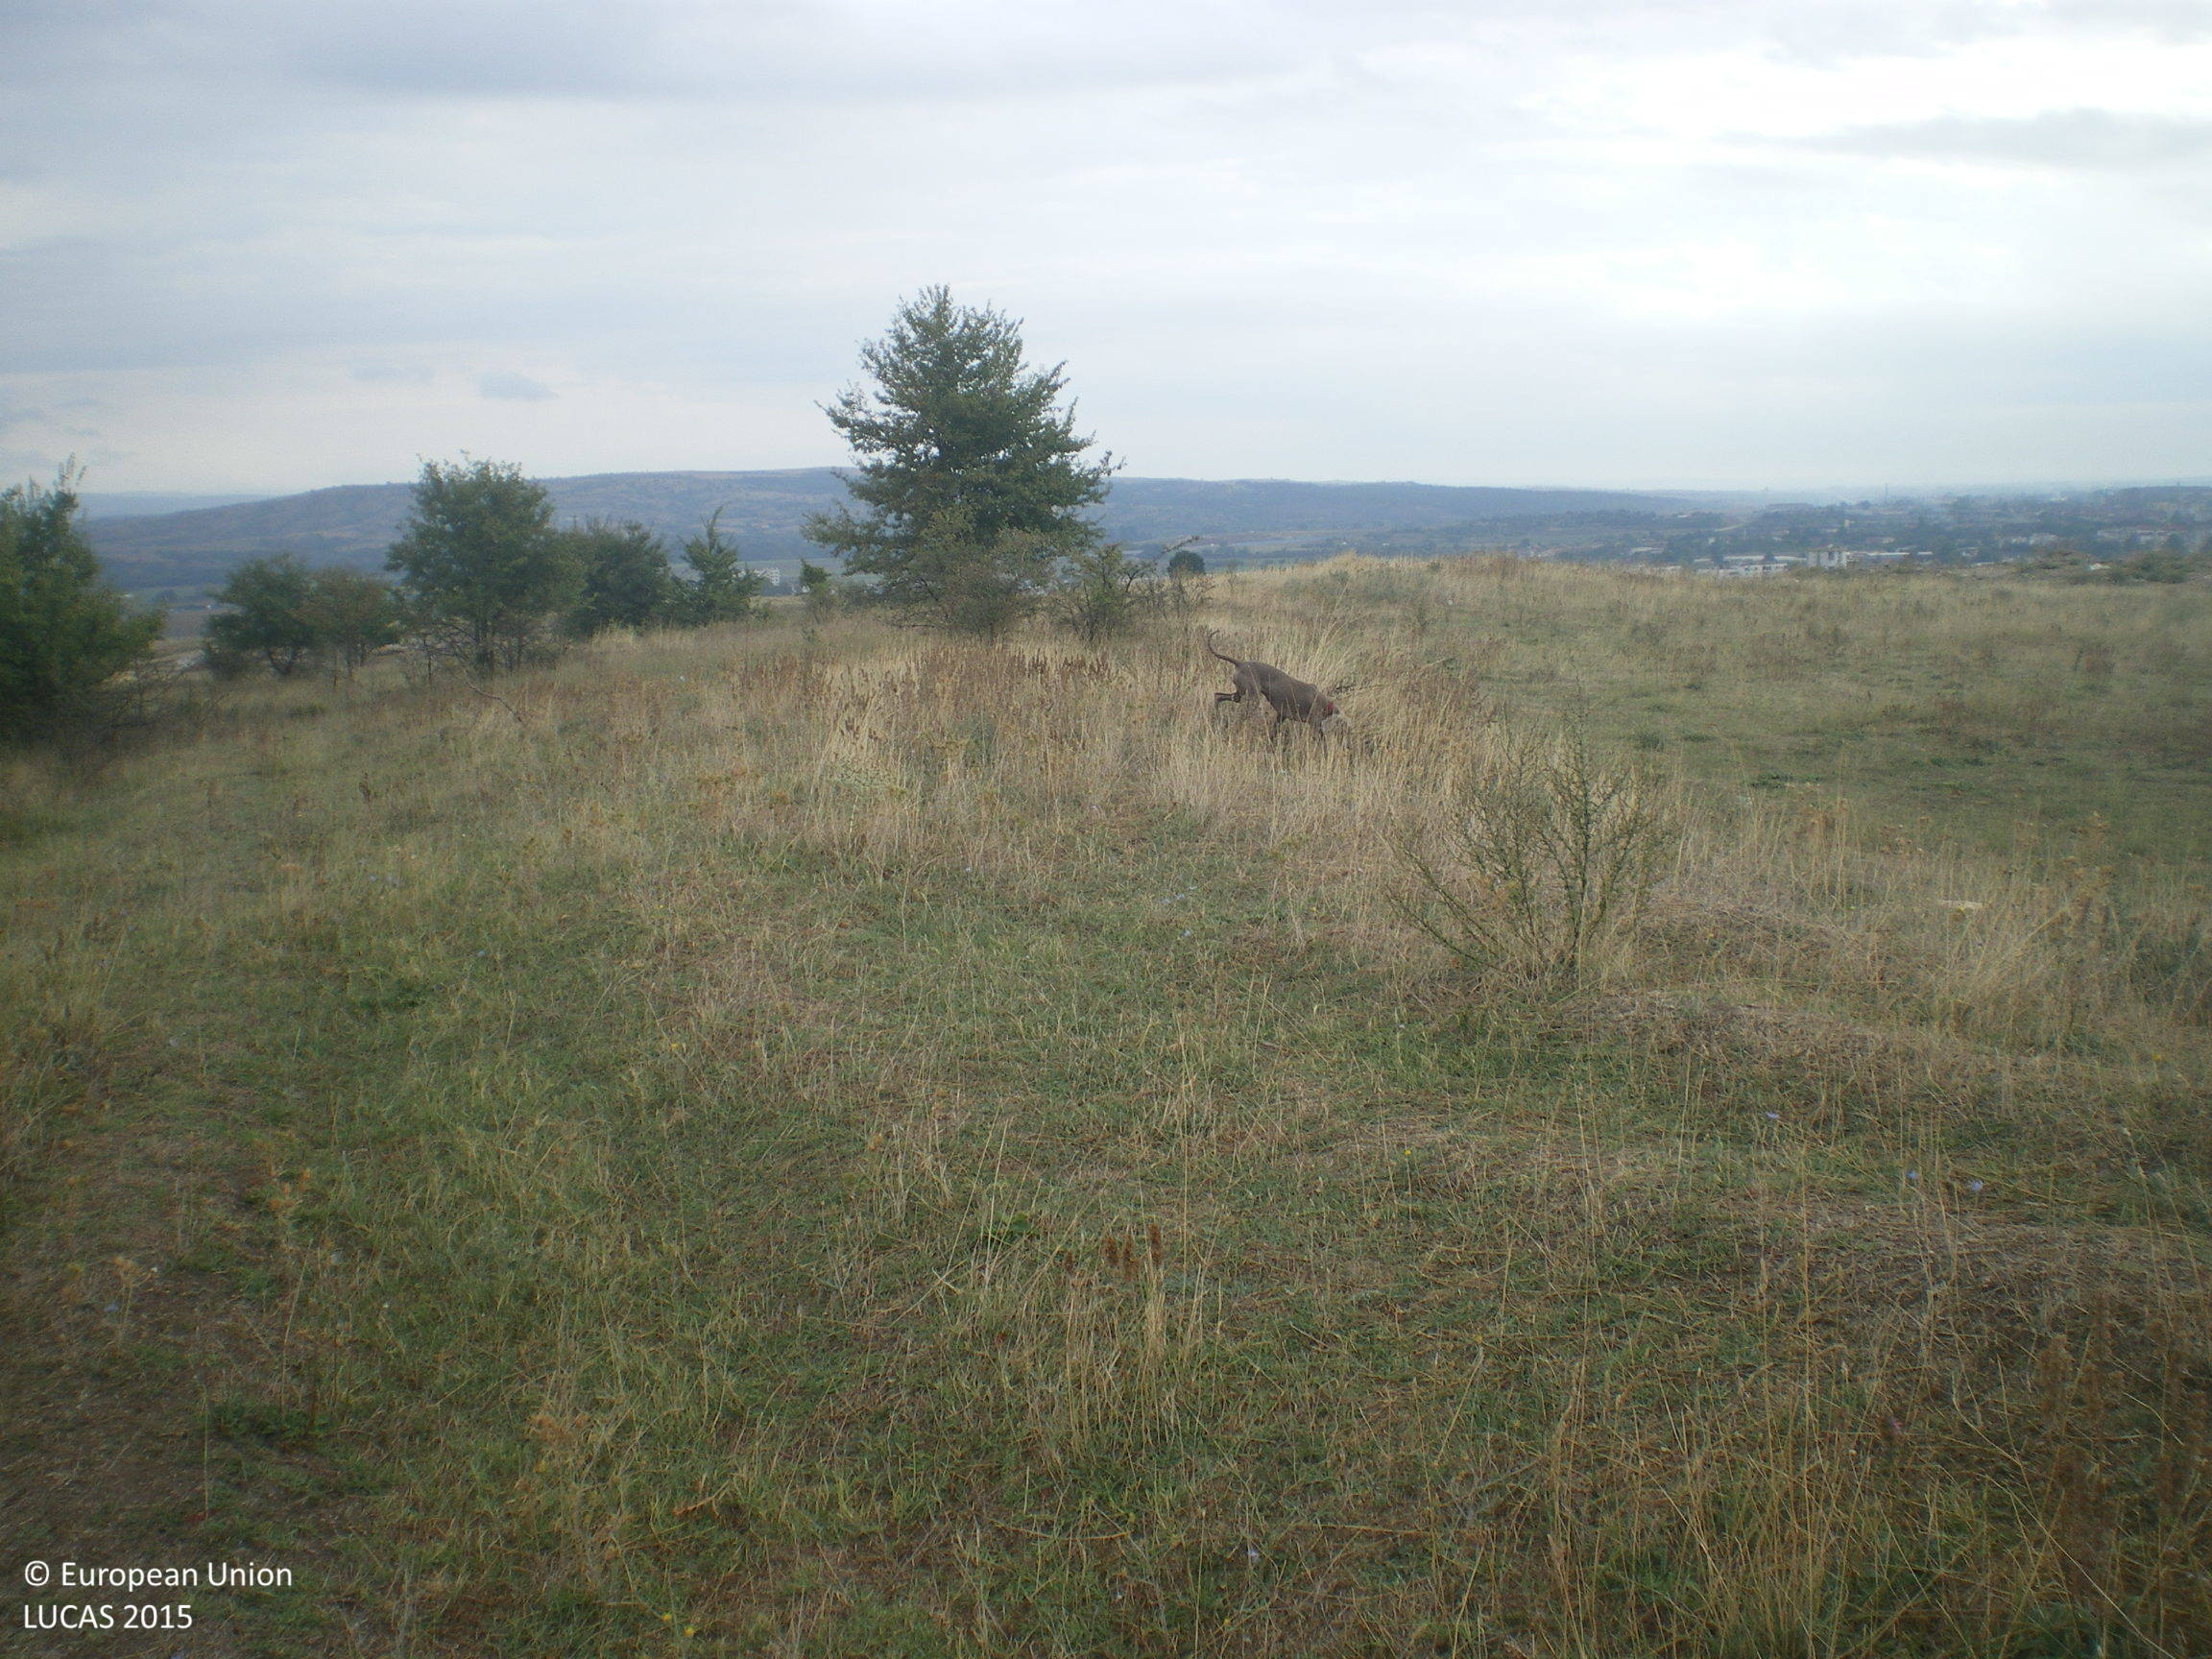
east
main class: Grassland
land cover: Grassland with sparse tree/shrub cover
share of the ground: > 75 %
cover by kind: herbaceous plants 90 %, broadleaved forest trees 5 %, shrubs 5 %
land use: Waste treatment
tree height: > 5 m
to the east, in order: Grassland with sparse tree/shrub cover; Shrubland with sparse tree cover; Other bare soil; Paved roads, cycling and walking lanes; Grassland with sparse tree/shrub cover
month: September
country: BG
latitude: 41.9423
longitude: 25.8844
